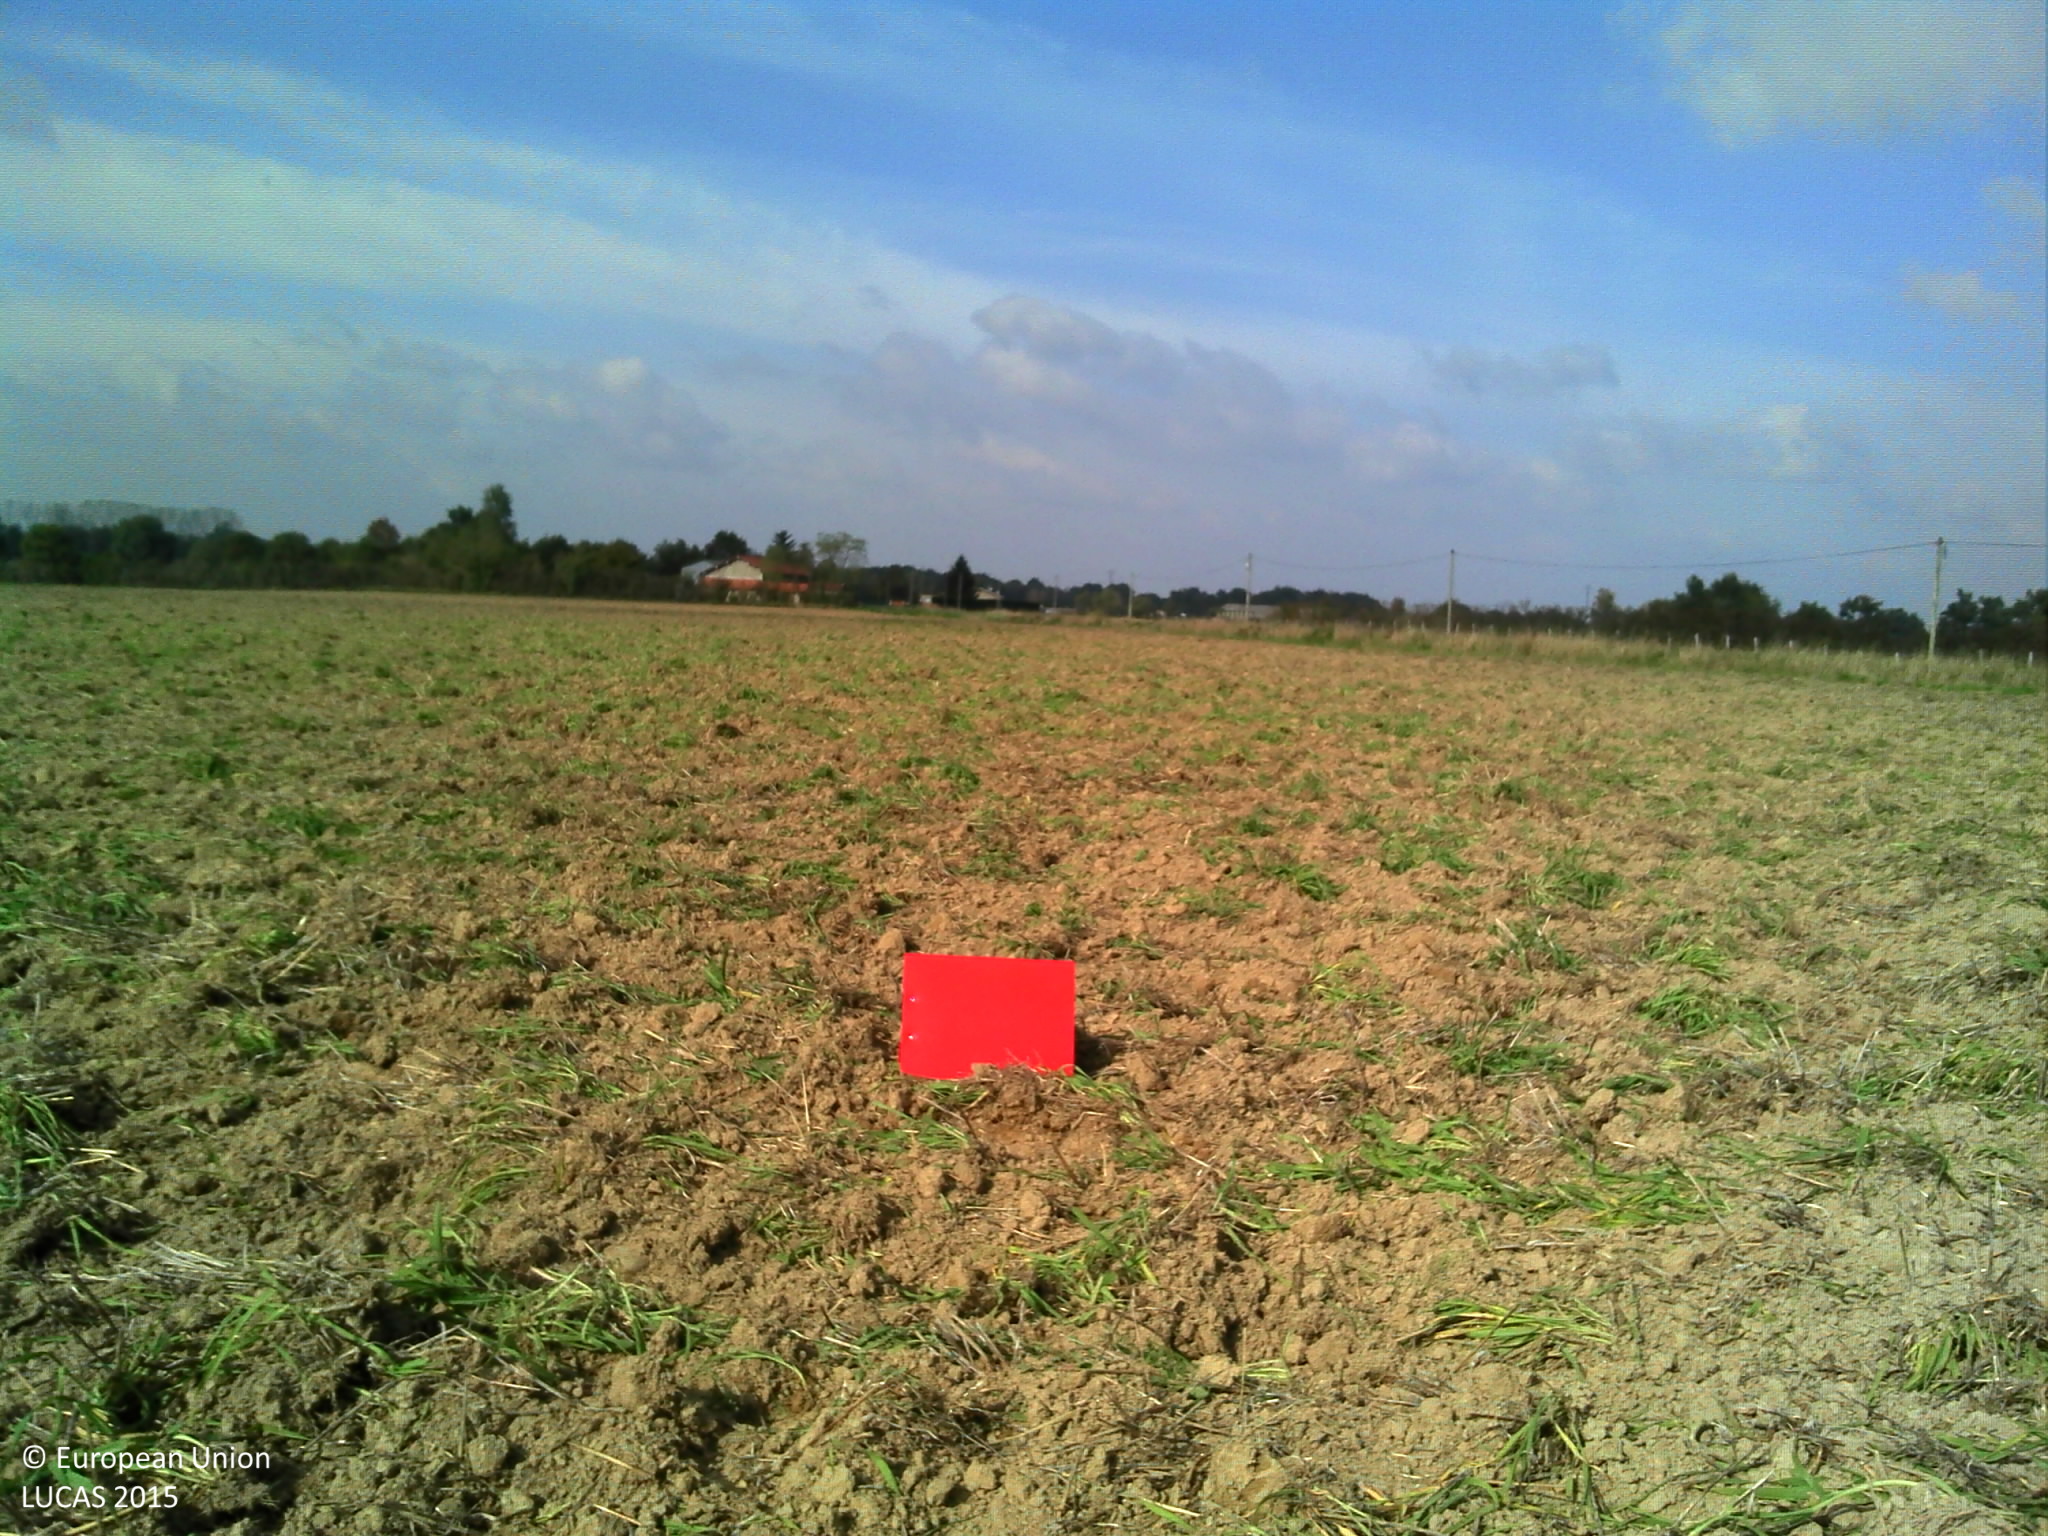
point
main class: Cropland
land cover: Common wheat
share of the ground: 10 - 25 %
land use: Agriculture (excluding fallow land and kitchen gardens)
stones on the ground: < 10 %
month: October
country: FR
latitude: 46.0886
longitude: 4.9720
